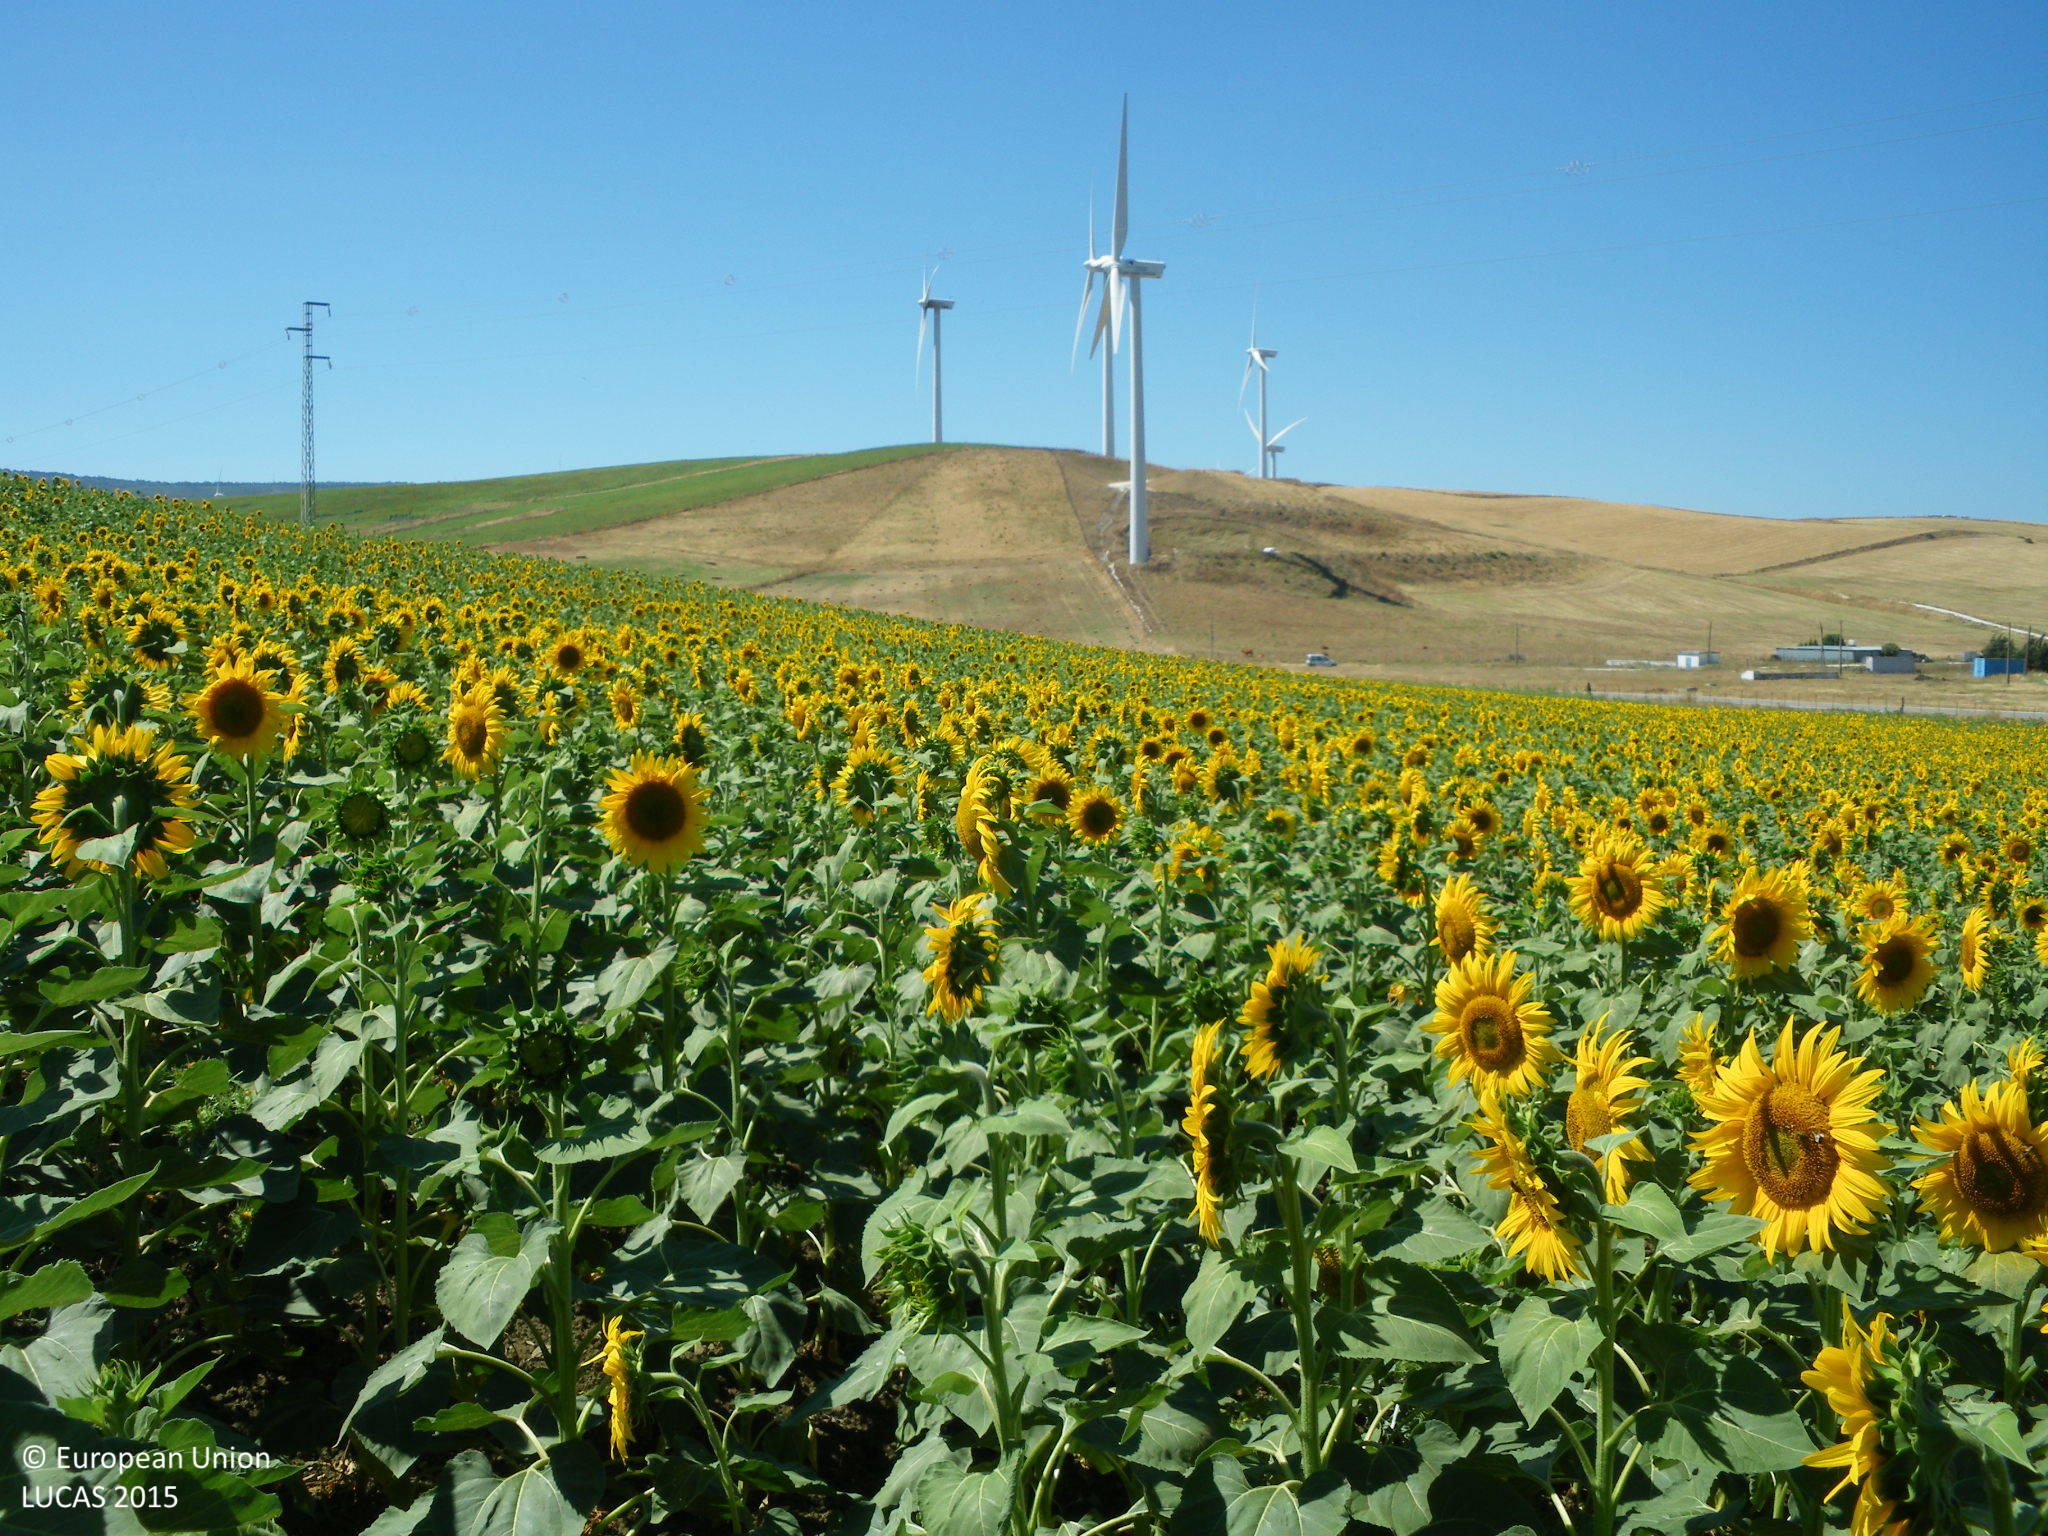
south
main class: Cropland
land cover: Sunflower
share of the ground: > 75 %
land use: Agriculture (excluding fallow land and kitchen gardens)
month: June
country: ES
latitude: 36.1570
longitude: -5.8140
